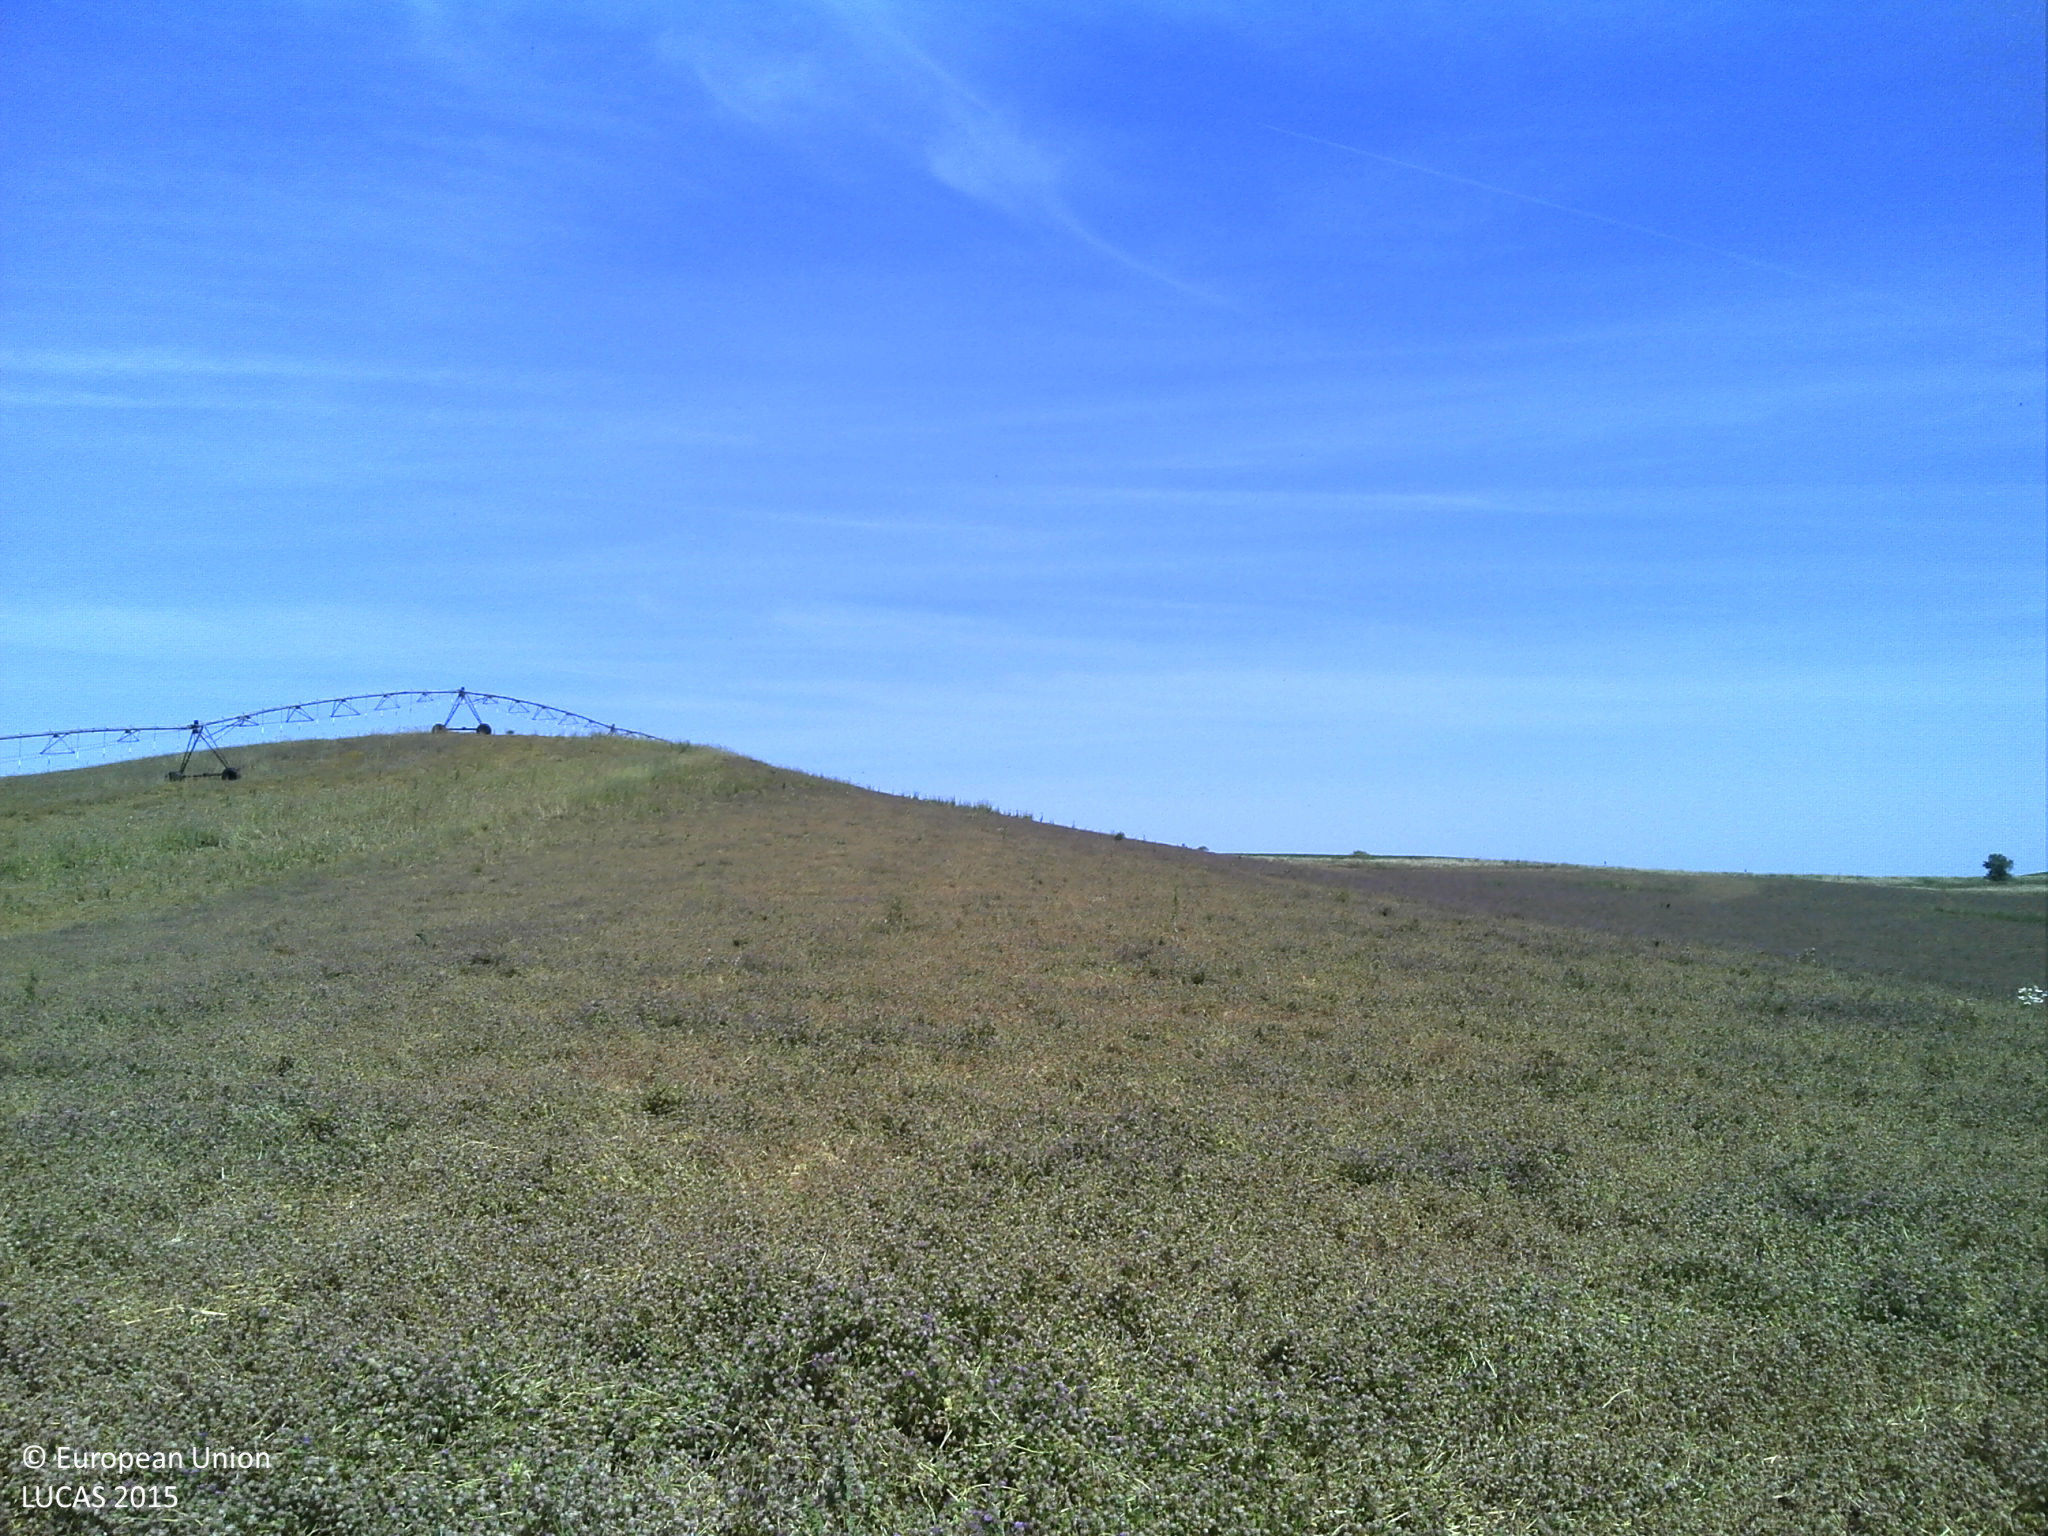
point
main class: Cropland
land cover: Clovers
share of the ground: > 75 %
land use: Agriculture (excluding fallow land and kitchen gardens)
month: May
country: PT
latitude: 39.0864
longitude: -7.6026
